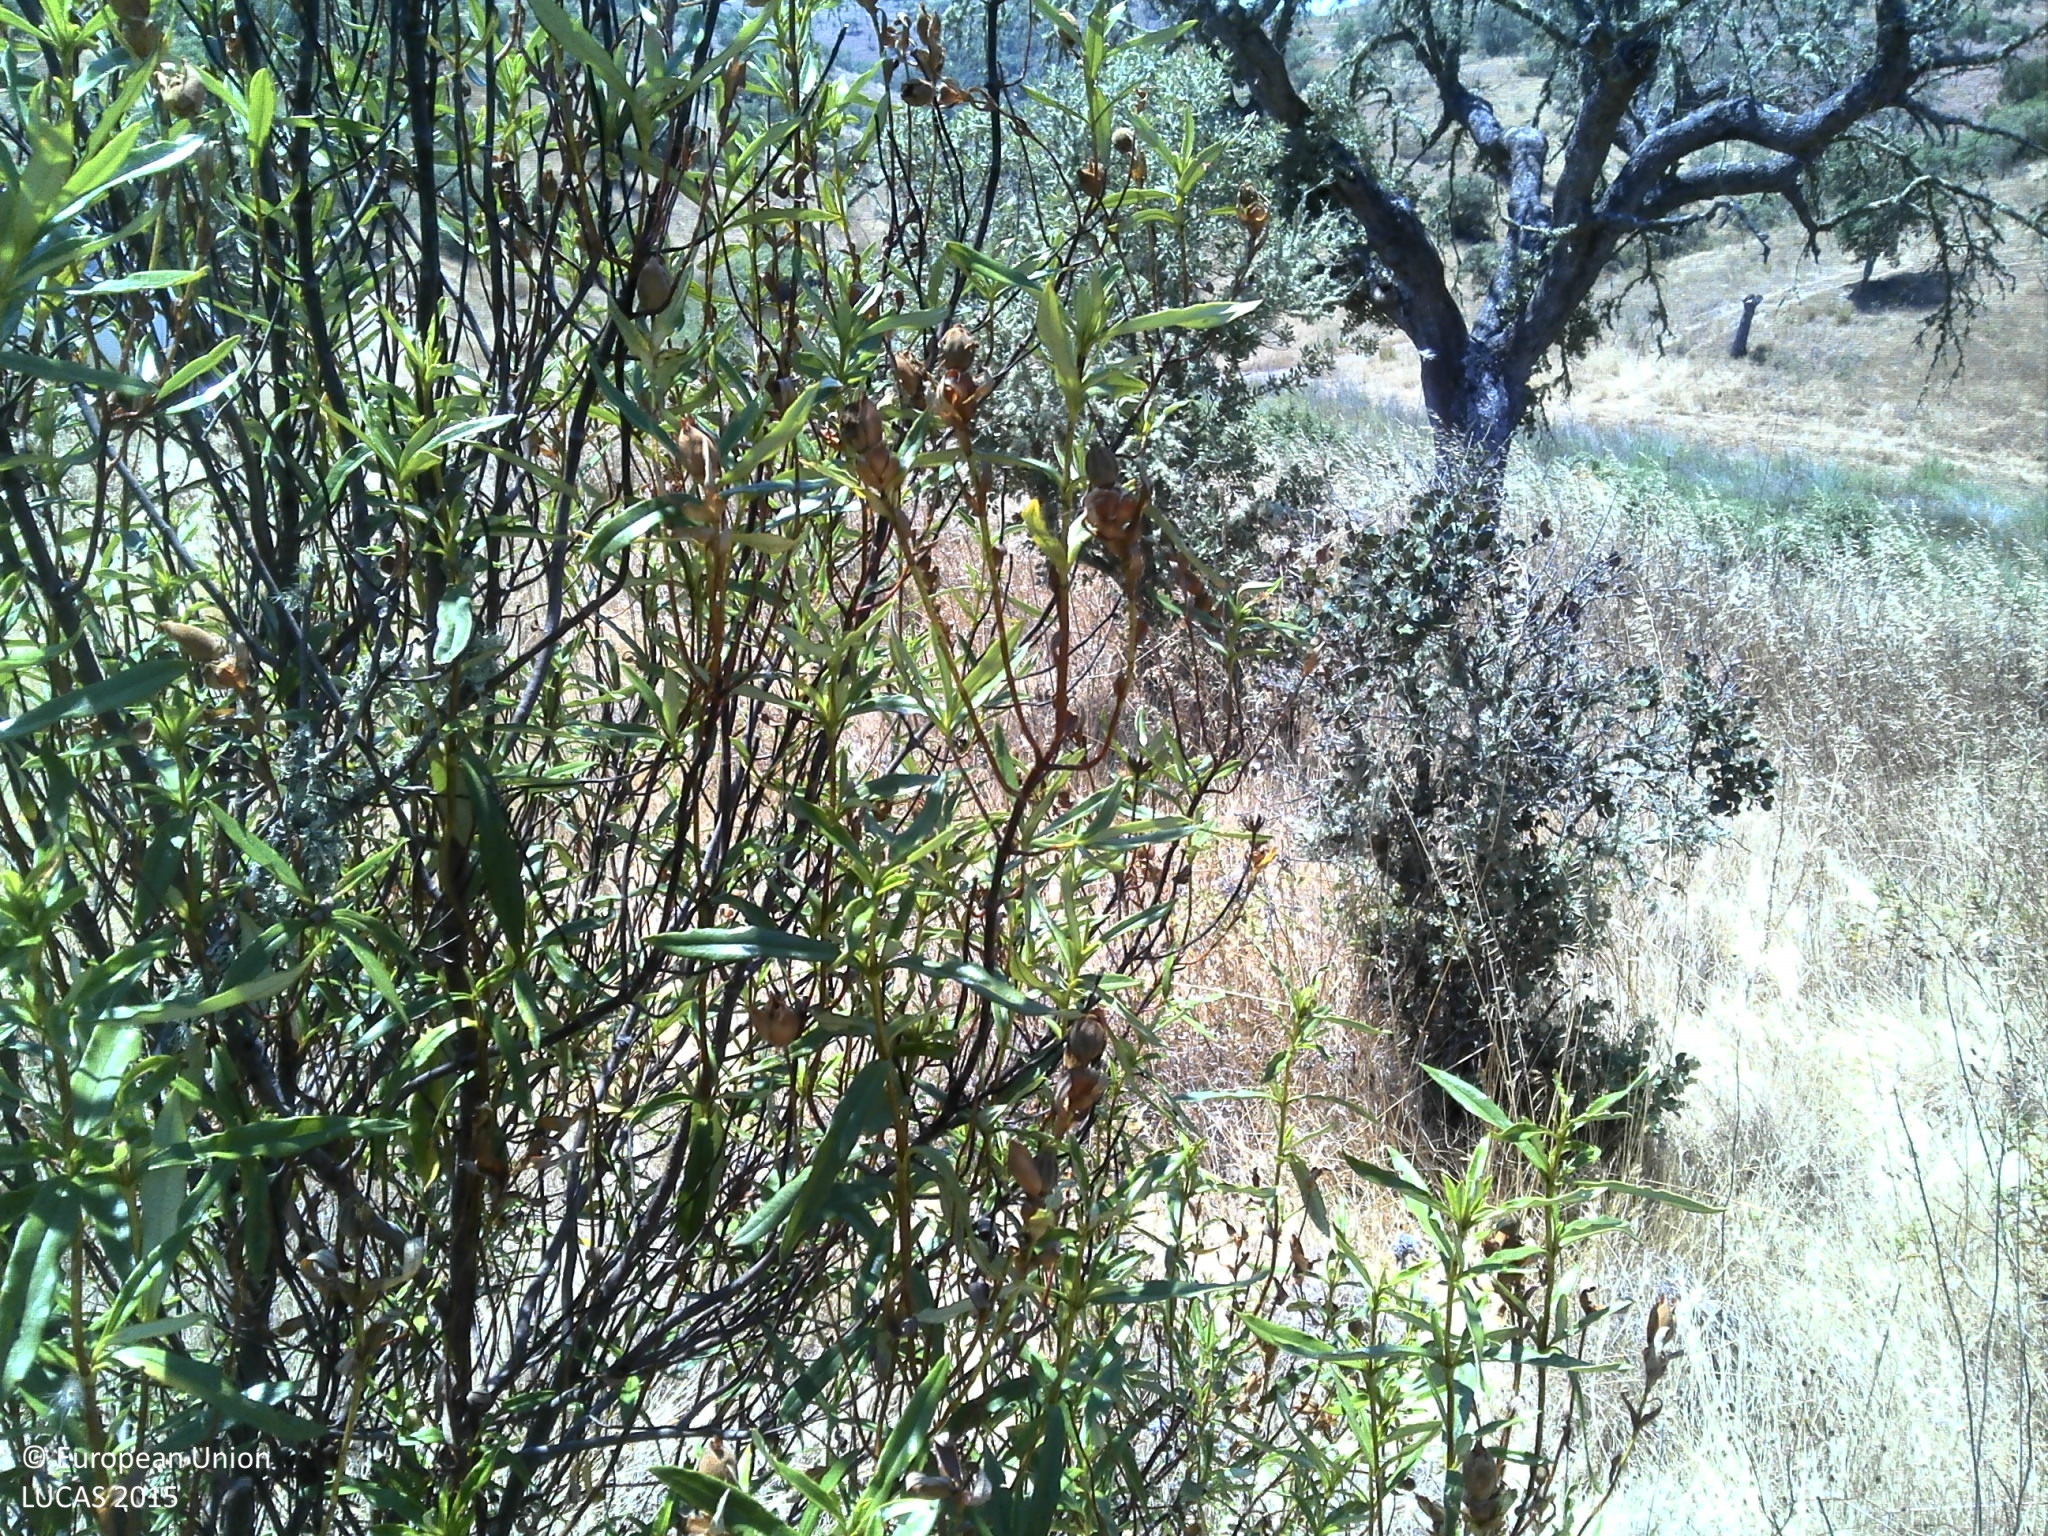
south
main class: Shrubland
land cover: Shrubland with sparse tree cover
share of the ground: 25 - 50 %
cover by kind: shrubs 50 %, herbaceous plants 30 %, unconsolidated bare surface 15 %, broadleaved forest trees 5 %
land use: Agriculture (excluding fallow land and kitchen gardens)
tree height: > 5 m
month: June
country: PT
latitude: 37.8699
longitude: -7.4888
